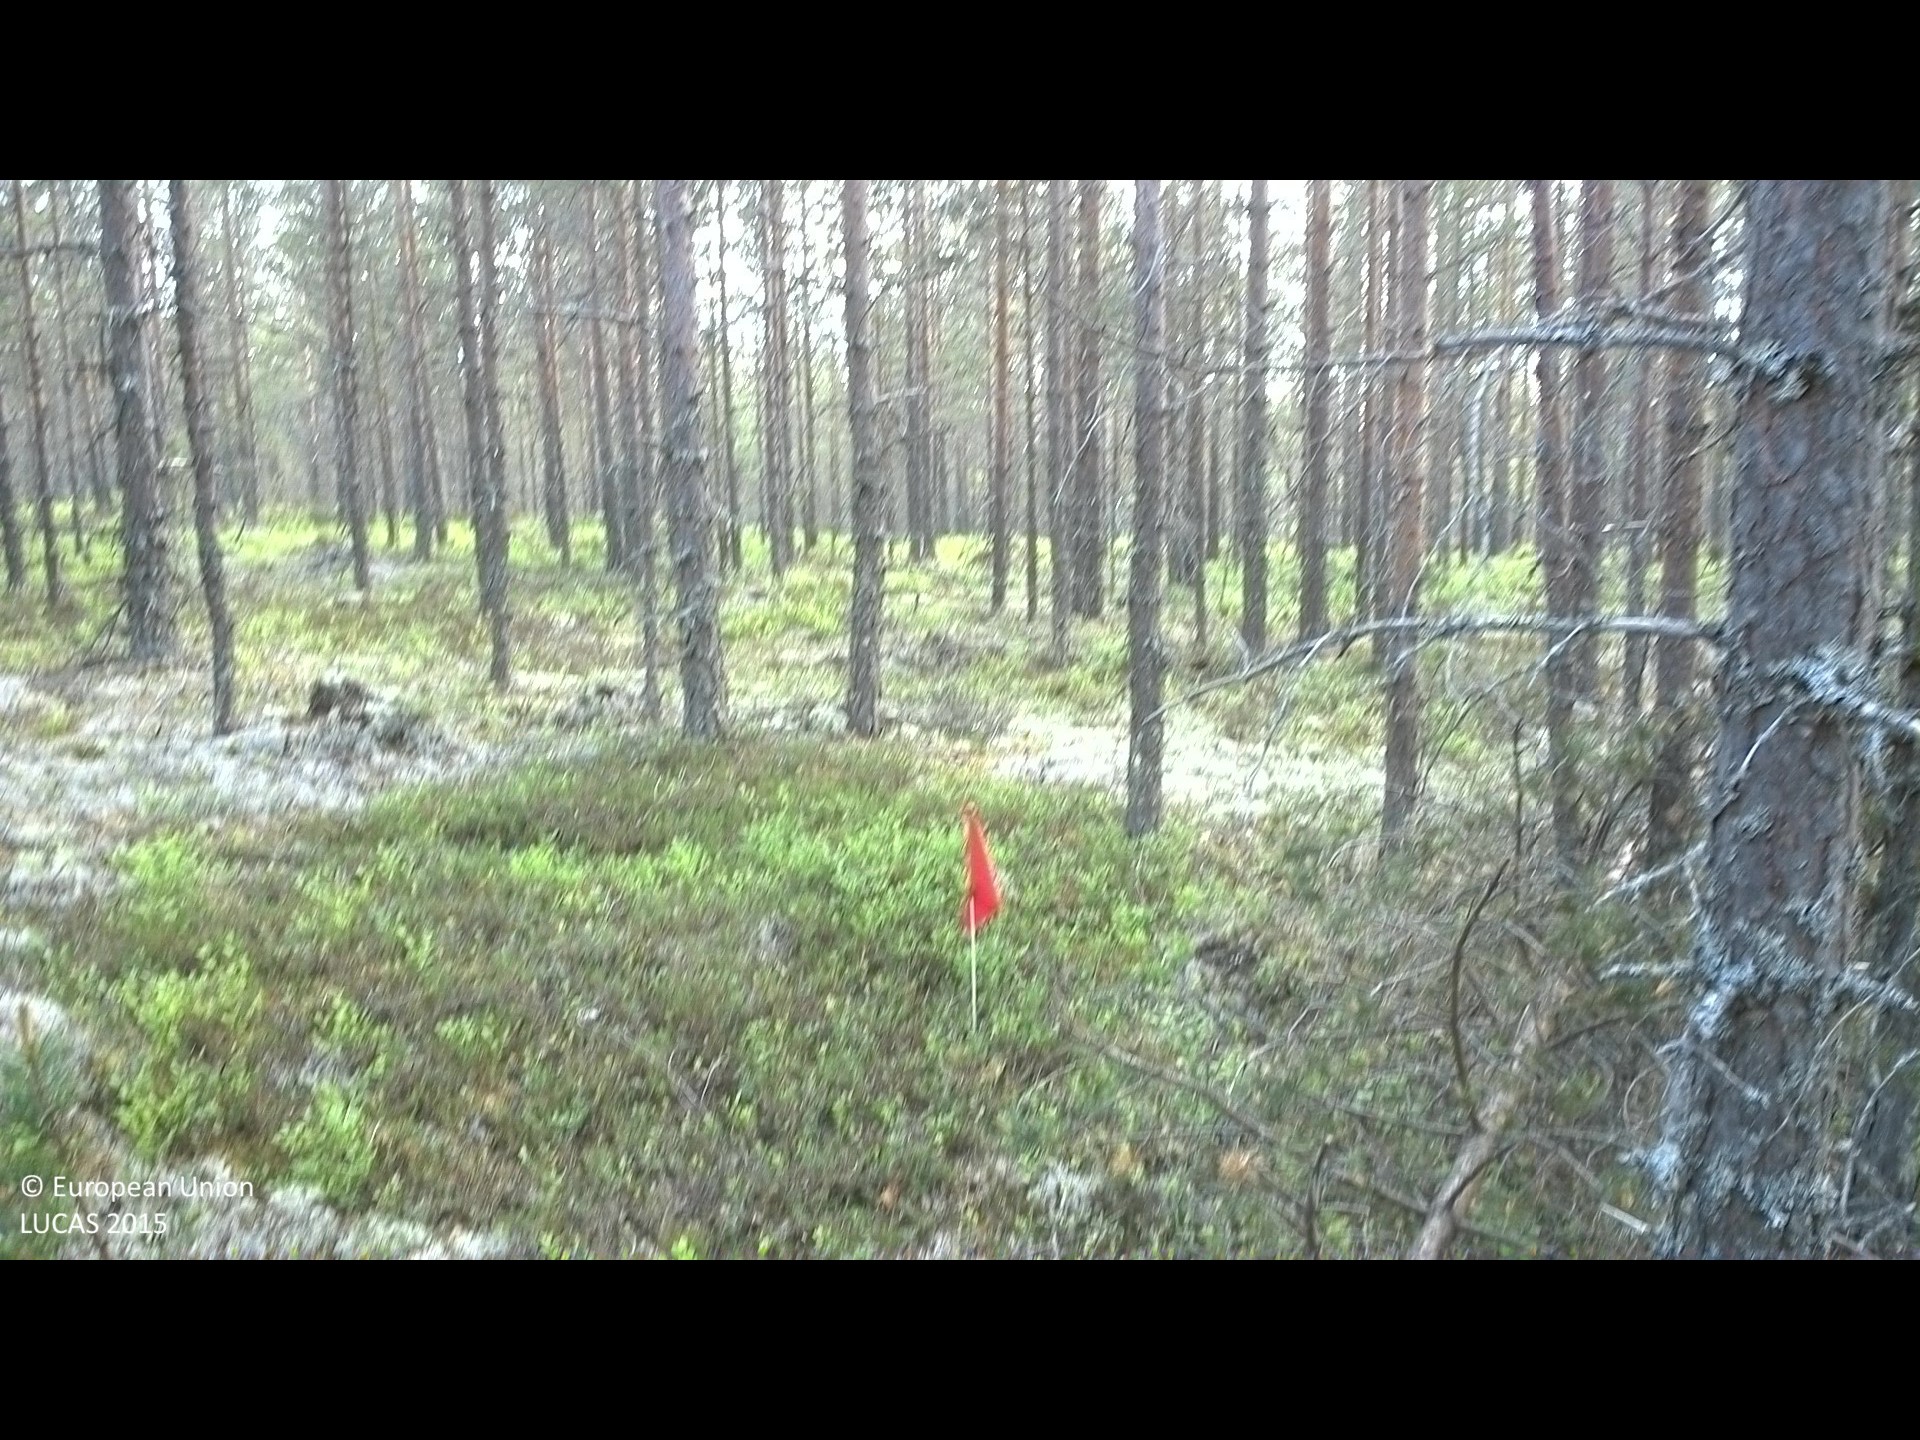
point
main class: Woodland
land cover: Pine dominated coniferous woodland
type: boreal forest
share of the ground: 25 - 50 %
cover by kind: lichens and mosses 50 %, coniferous forest trees 30 %, shrubs 20 %
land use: Forestry
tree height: > 5 m
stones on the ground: < 10 %
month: June
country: SE
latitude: 61.9576
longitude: 16.6747
